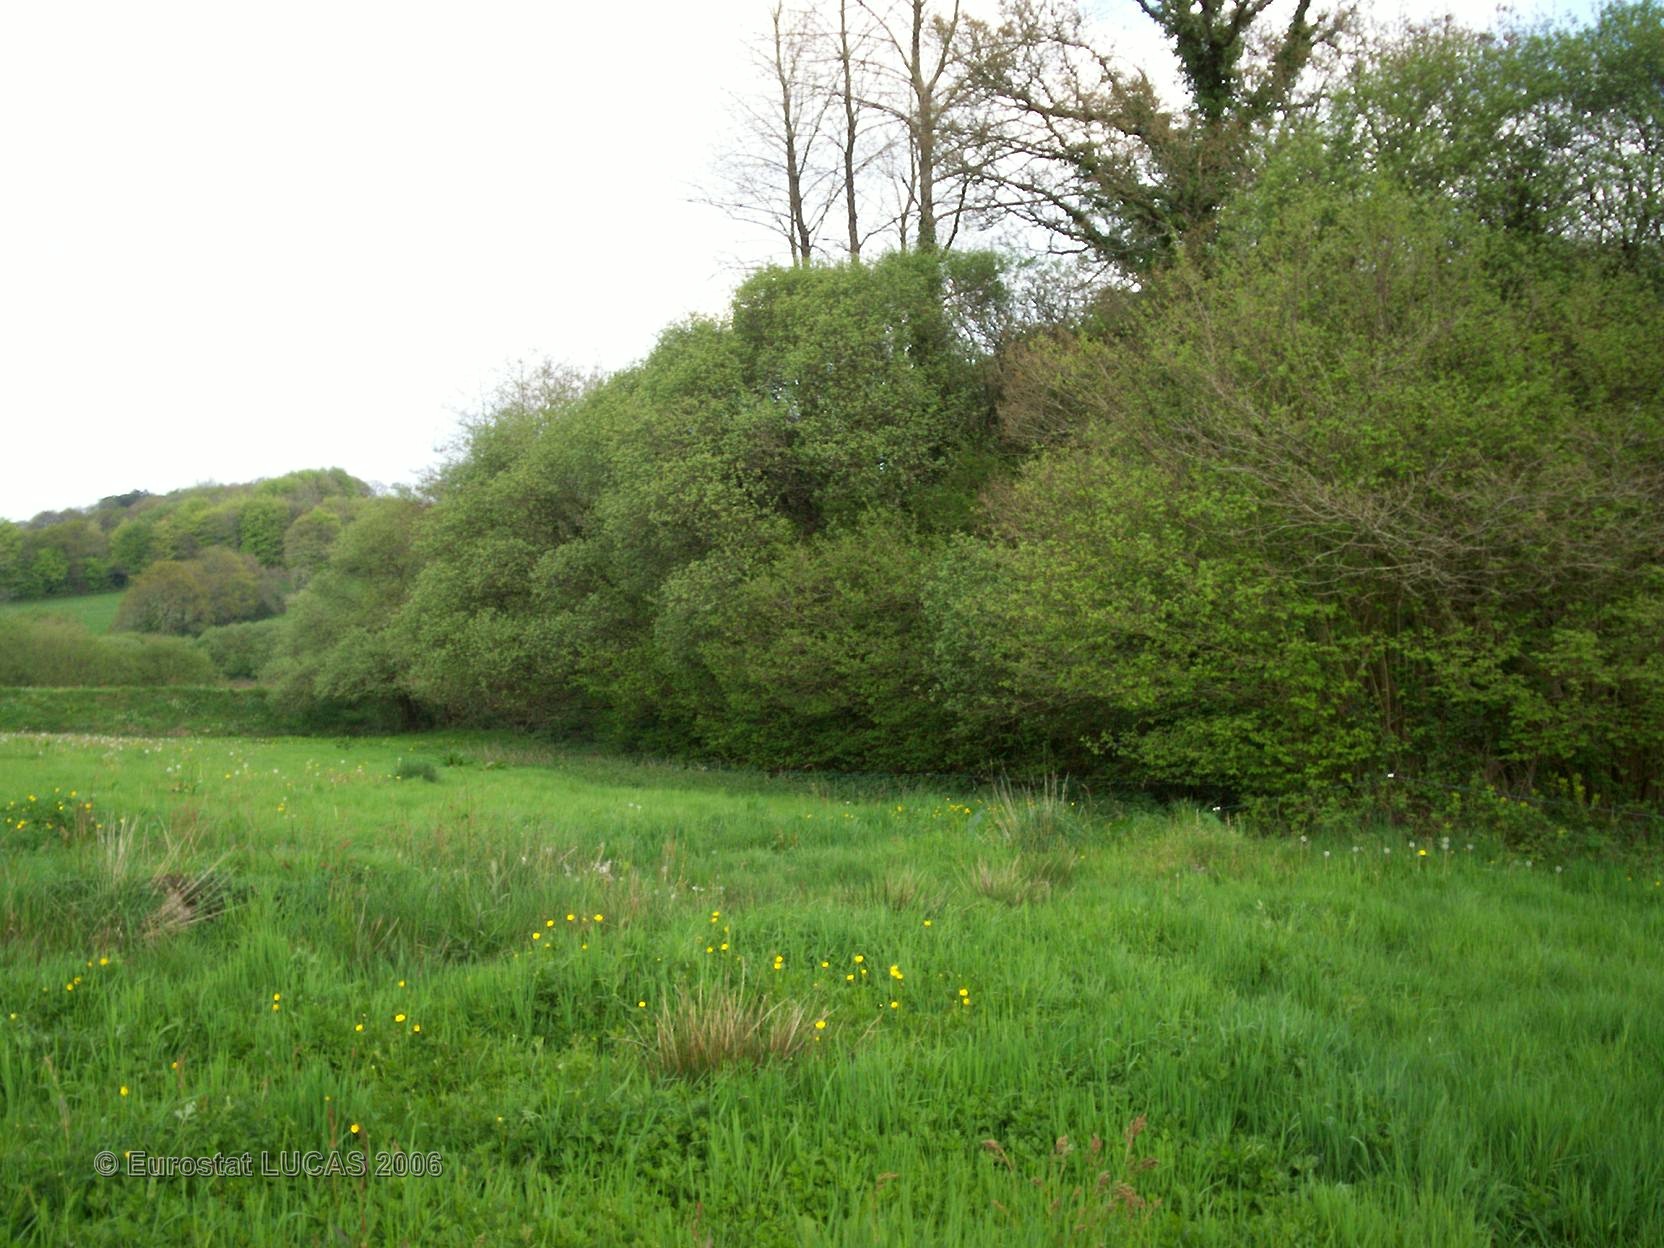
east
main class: Grassland
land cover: Grassland without tree/shrub cover
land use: Agriculture (excluding fallow land and kitchen gardens)
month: May
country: FR
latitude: 48.4295
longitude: -3.6368
